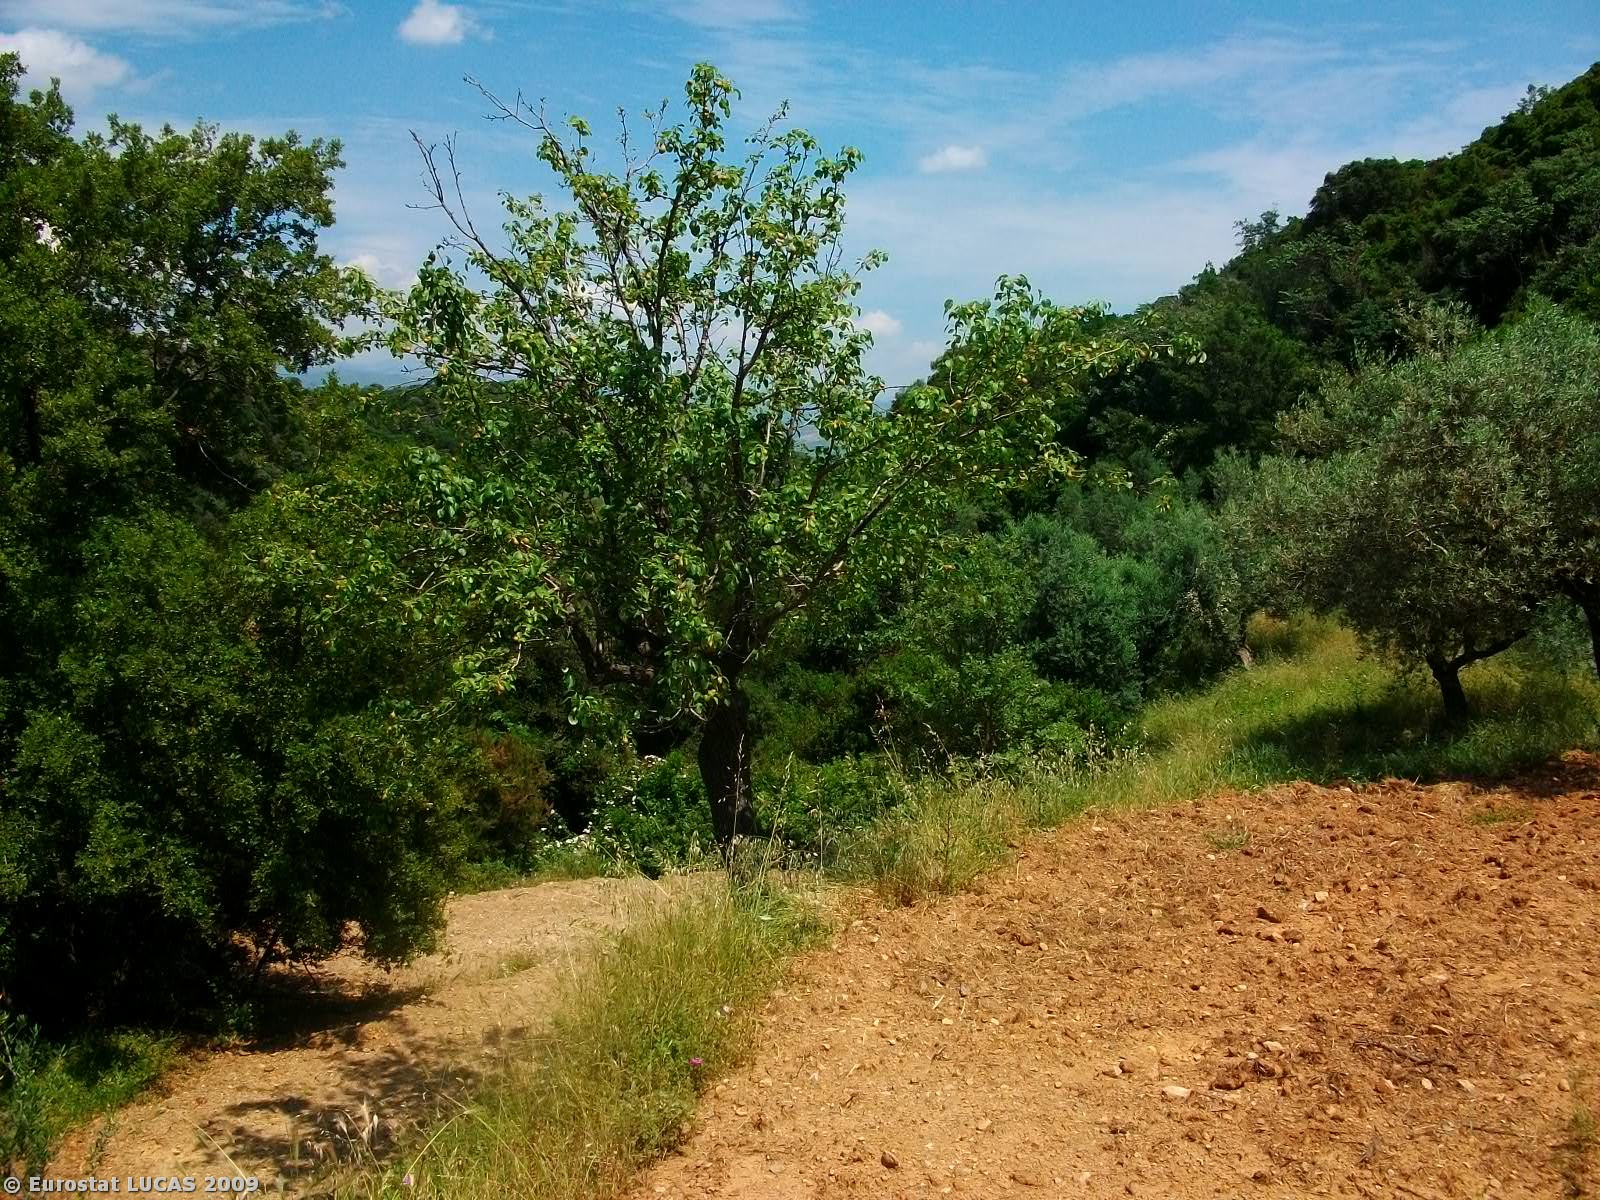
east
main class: Cropland
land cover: Olive groves
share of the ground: 25 - 50 %
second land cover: Bare land
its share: 50 - 75 %
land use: Agriculture (excluding fallow land and kitchen gardens)
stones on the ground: 25 - 50 %
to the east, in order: Olive groves; Bare land; Shrubland with sparse tree cover; Olive groves; Shrubland with sparse tree cover; Olive groves
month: May
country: GR
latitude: 37.1198
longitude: 22.3702
